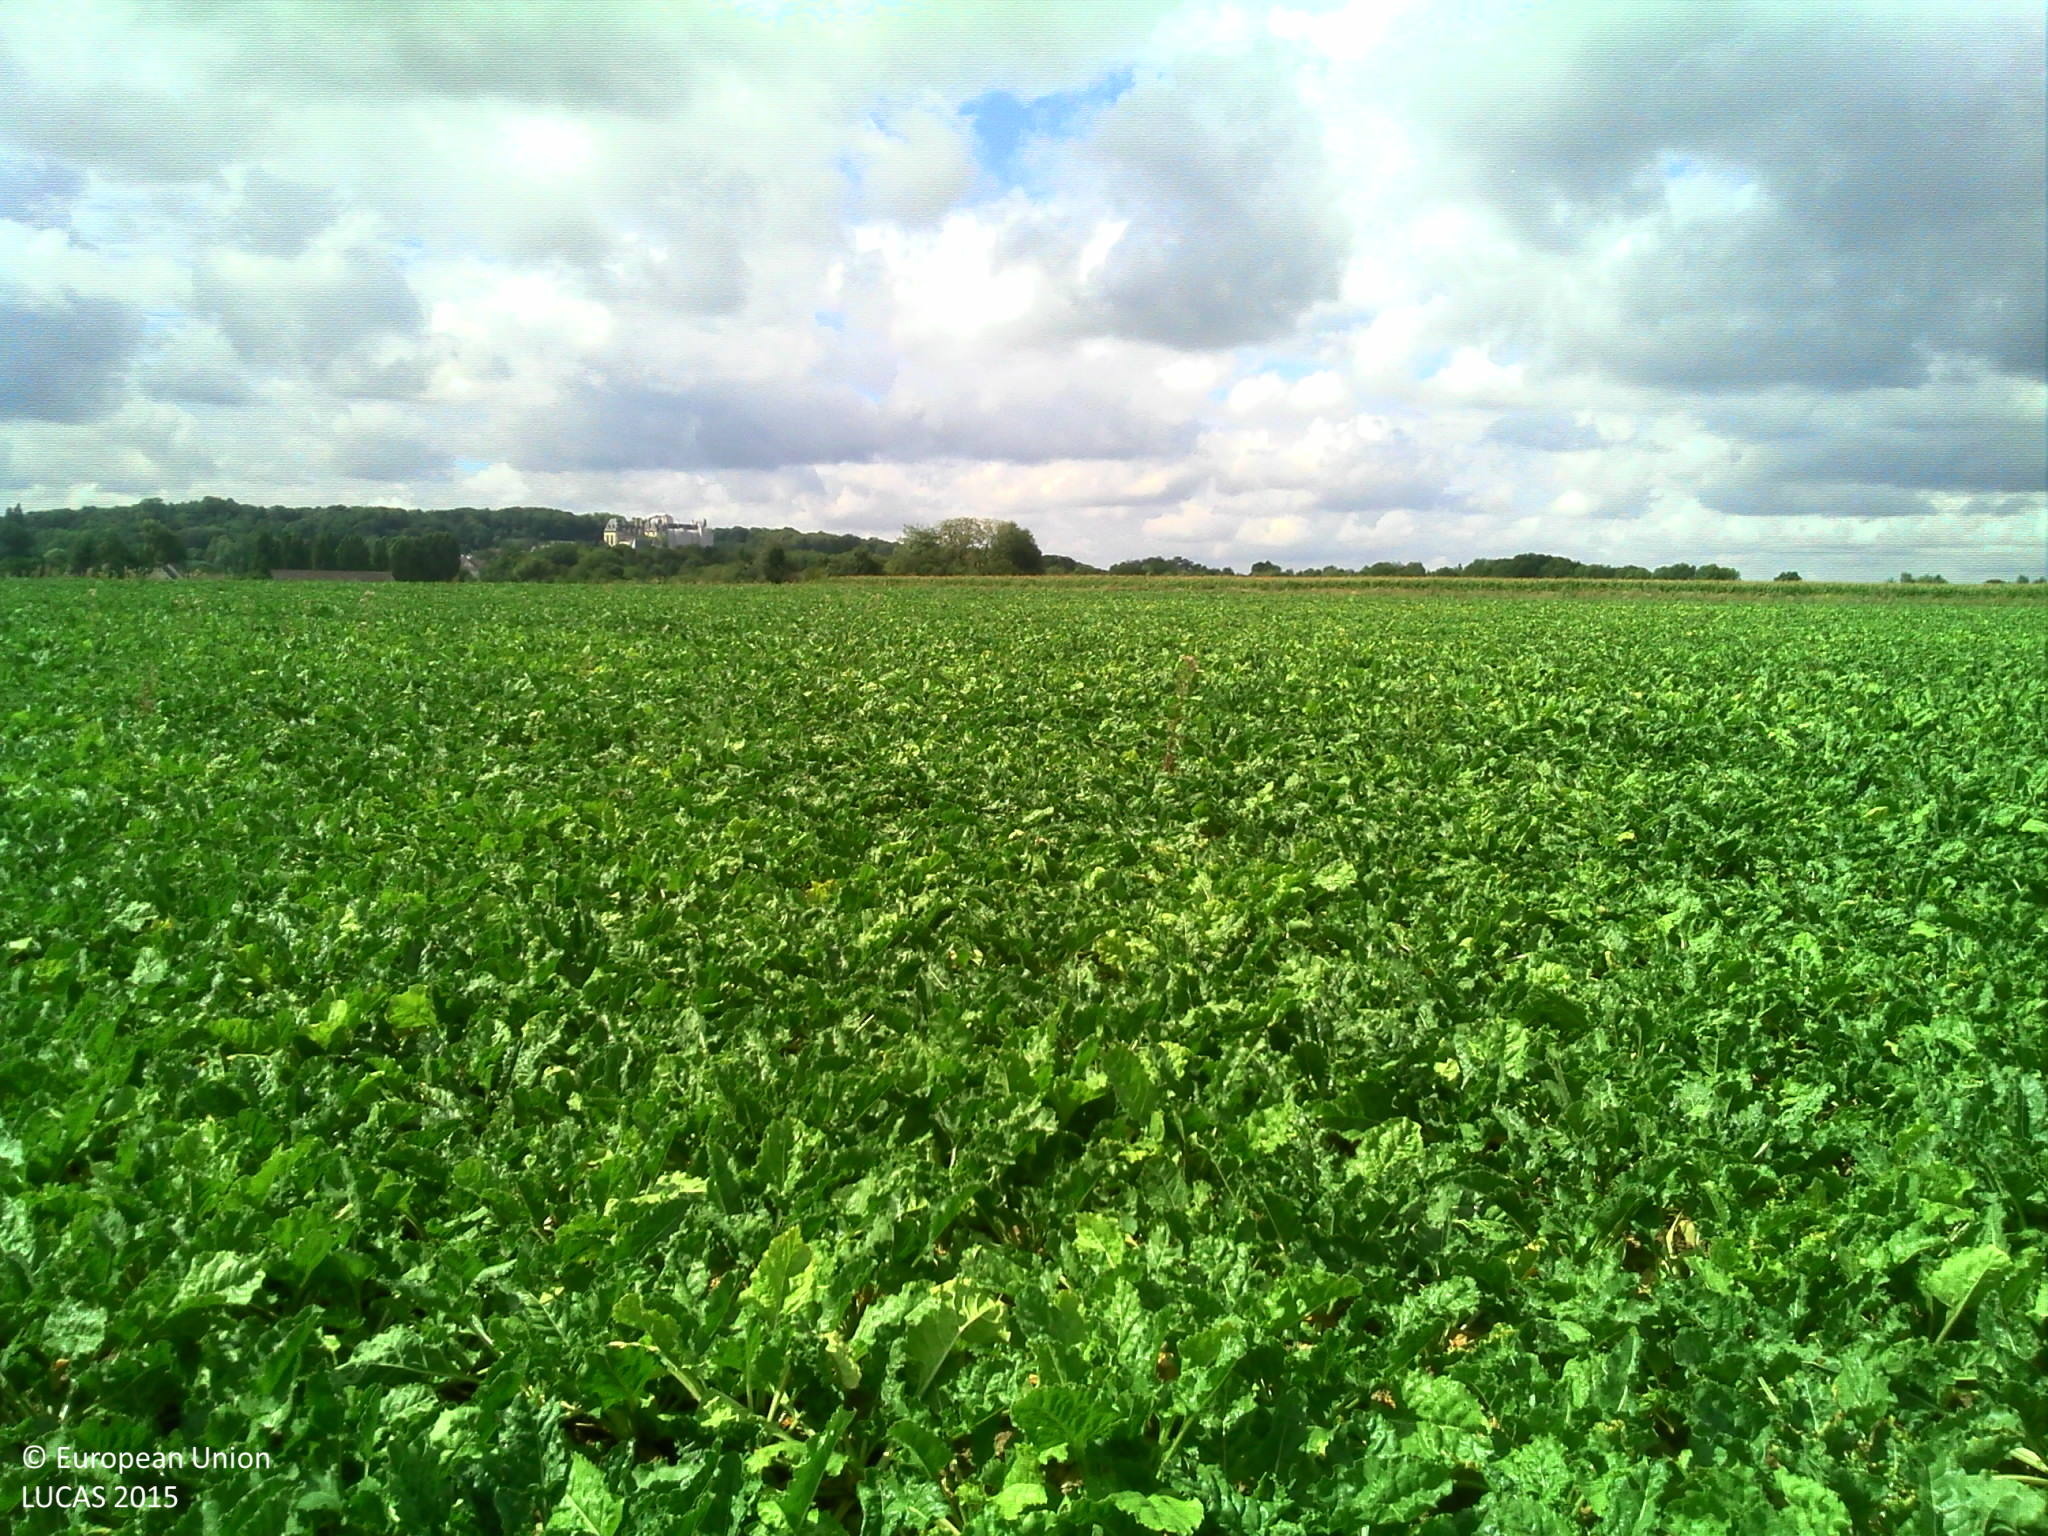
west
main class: Cropland
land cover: Sugar beet
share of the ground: > 75 %
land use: Agriculture (excluding fallow land and kitchen gardens)
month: August
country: FR
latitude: 49.0270
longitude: 2.3976
